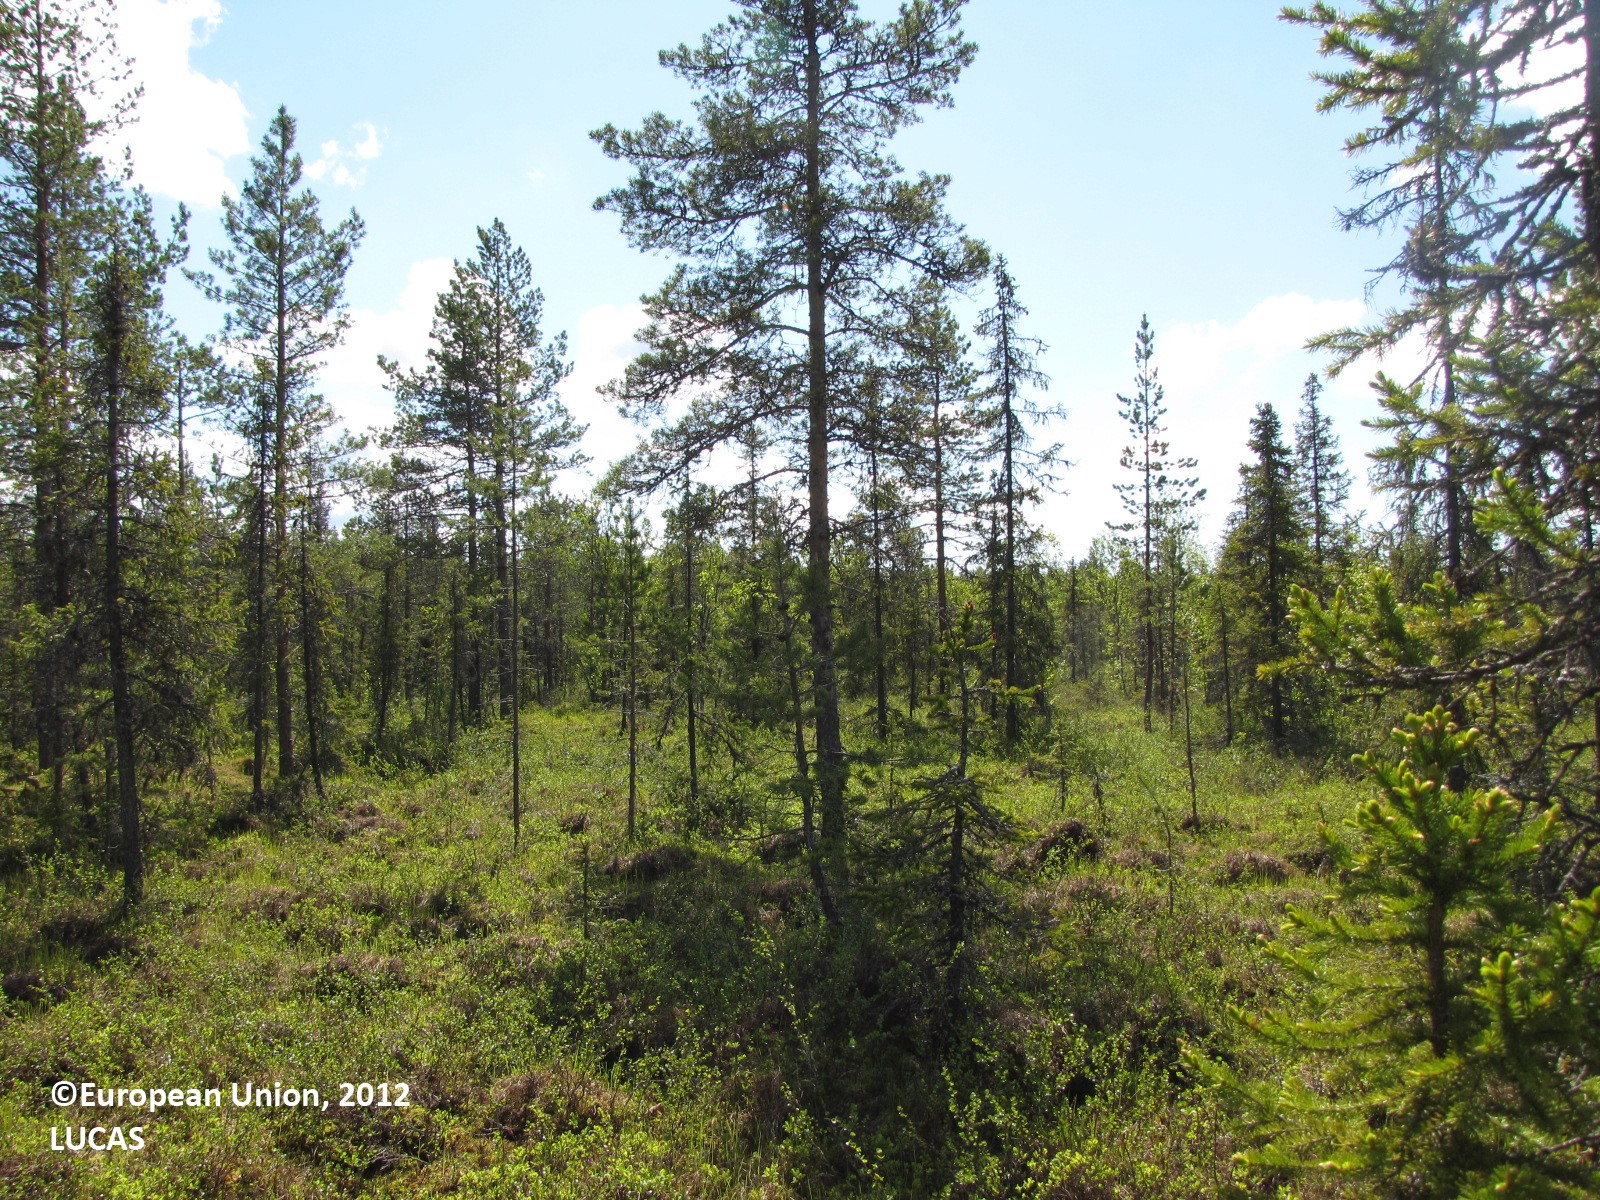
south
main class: Woodland
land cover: Spruce dominated coniferous woodland
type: boreal forest
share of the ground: 25 - 50 %
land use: Forestry
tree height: > 5 m
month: June
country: FI
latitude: 65.9757
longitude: 24.7380
